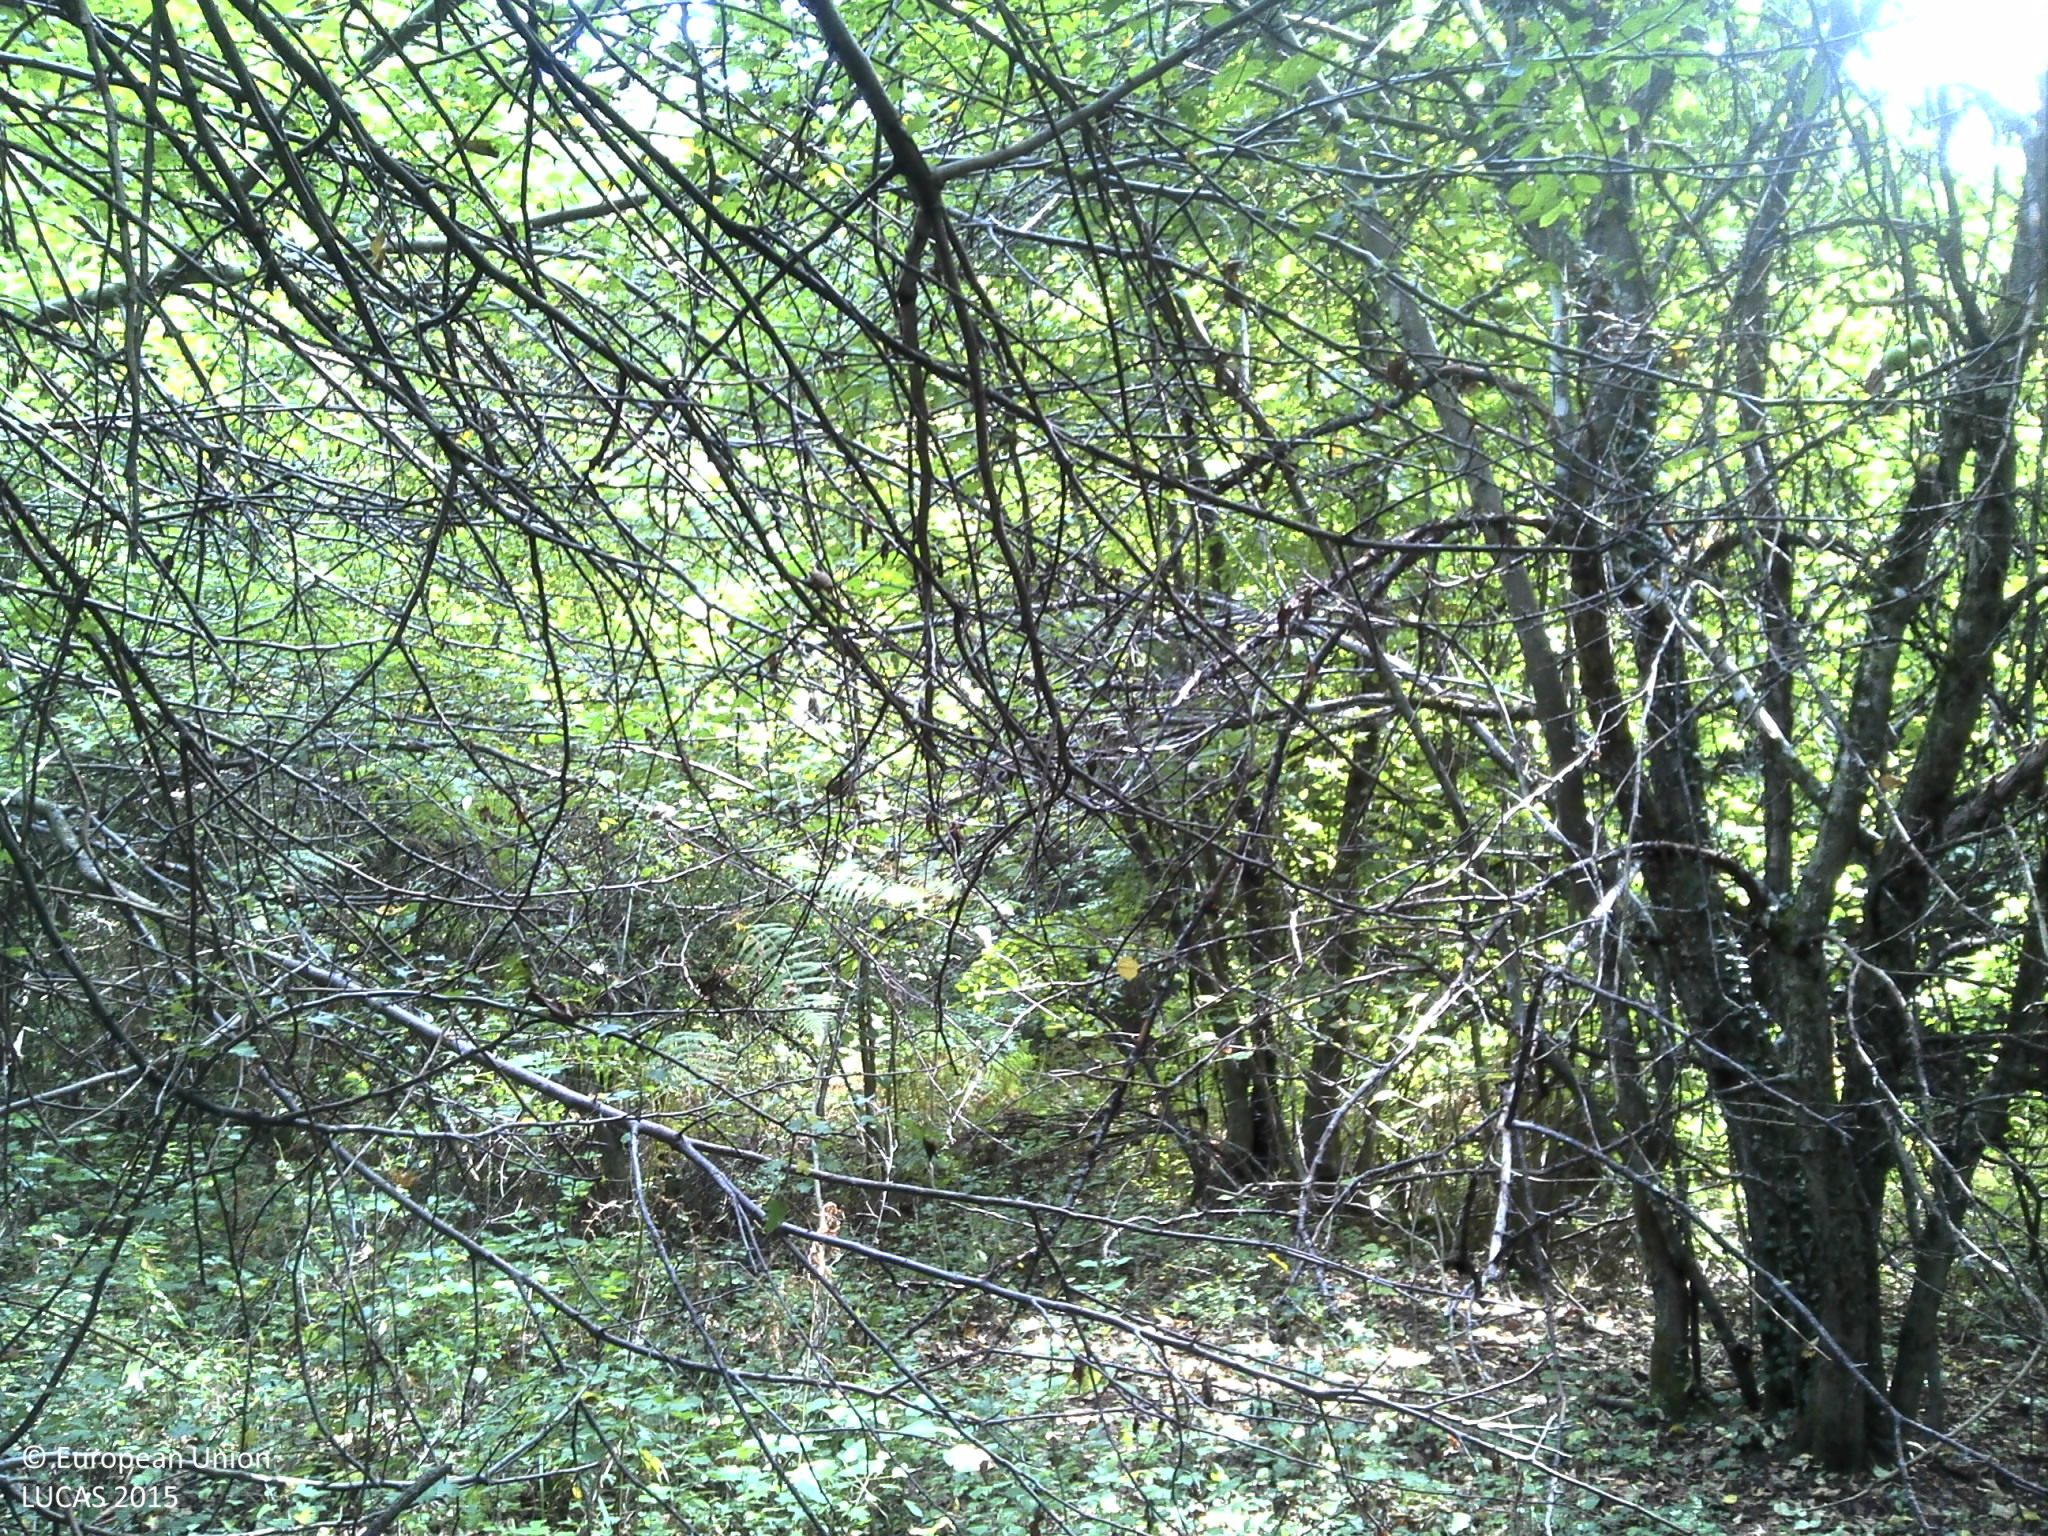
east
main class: Woodland
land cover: Broadleaved woodland
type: beech forest
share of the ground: > 75 %
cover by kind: broadleaved forest trees 100 %
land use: Forestry
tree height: > 5 m
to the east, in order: Broadleaved woodland
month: September
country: HR
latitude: 45.1748
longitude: 15.6070
